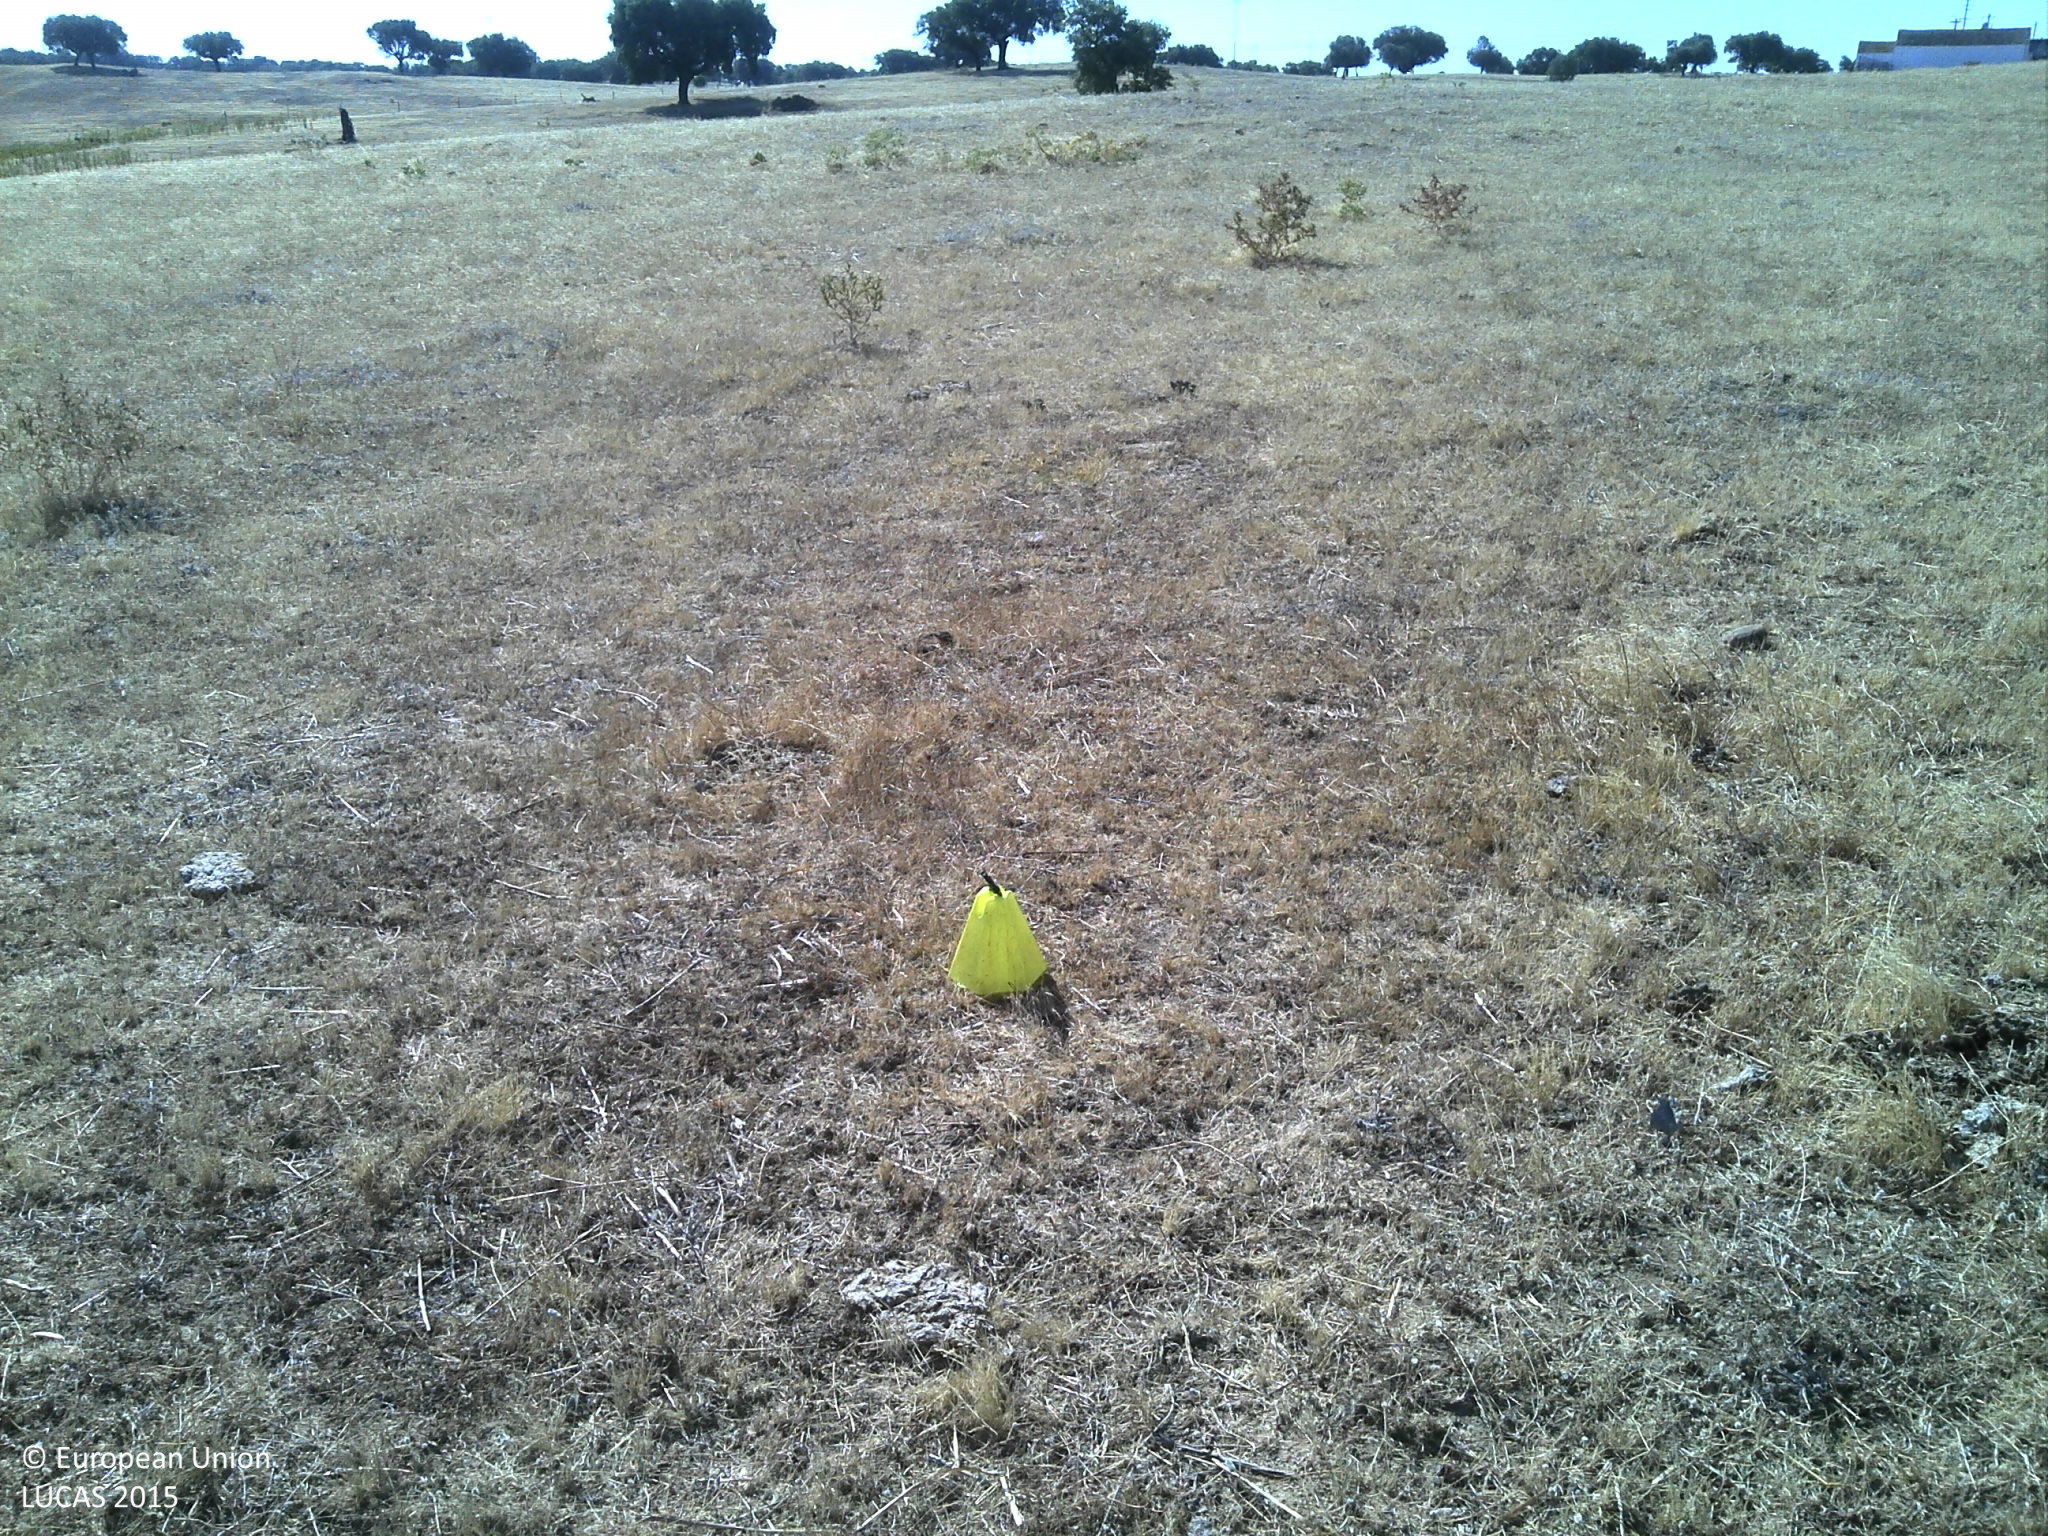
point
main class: Grassland
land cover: Grassland without tree/shrub cover
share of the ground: 25 - 50 %
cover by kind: unconsolidated bare surface 70 %, herbaceous plants 30 %
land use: Agriculture (excluding fallow land and kitchen gardens)
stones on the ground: < 10 %
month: July
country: PT
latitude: 39.0667
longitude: -7.4079
